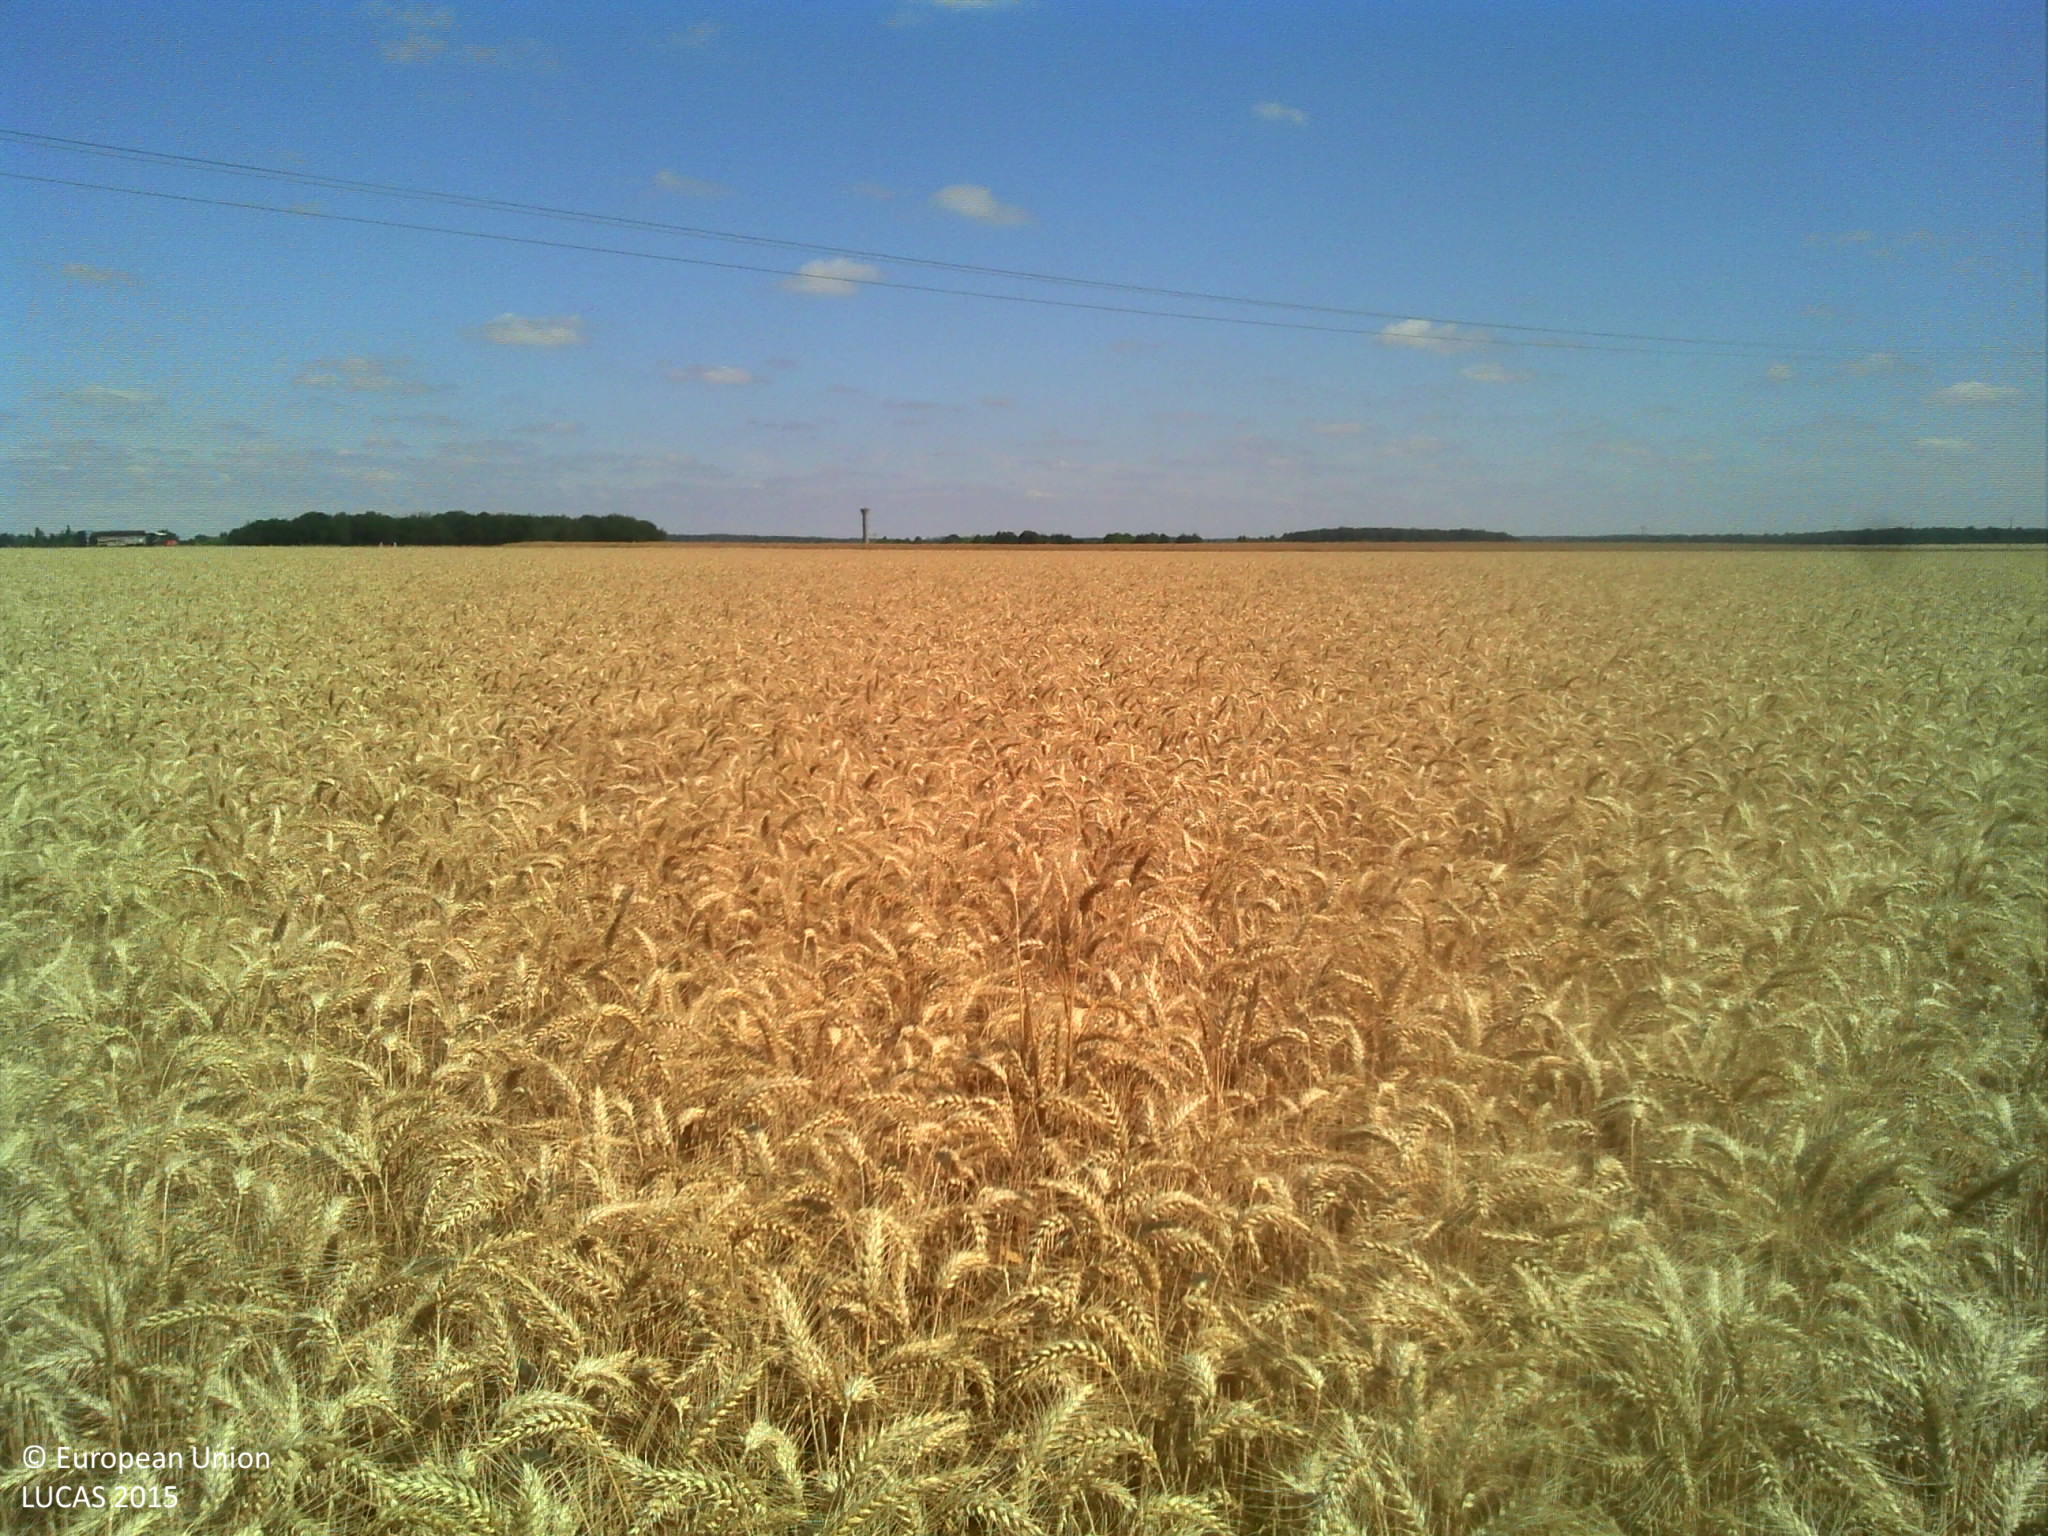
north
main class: Cropland
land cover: Common wheat
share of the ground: > 75 %
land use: Agriculture (excluding fallow land and kitchen gardens)
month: July
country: FR
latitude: 48.1137
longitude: 1.2921
